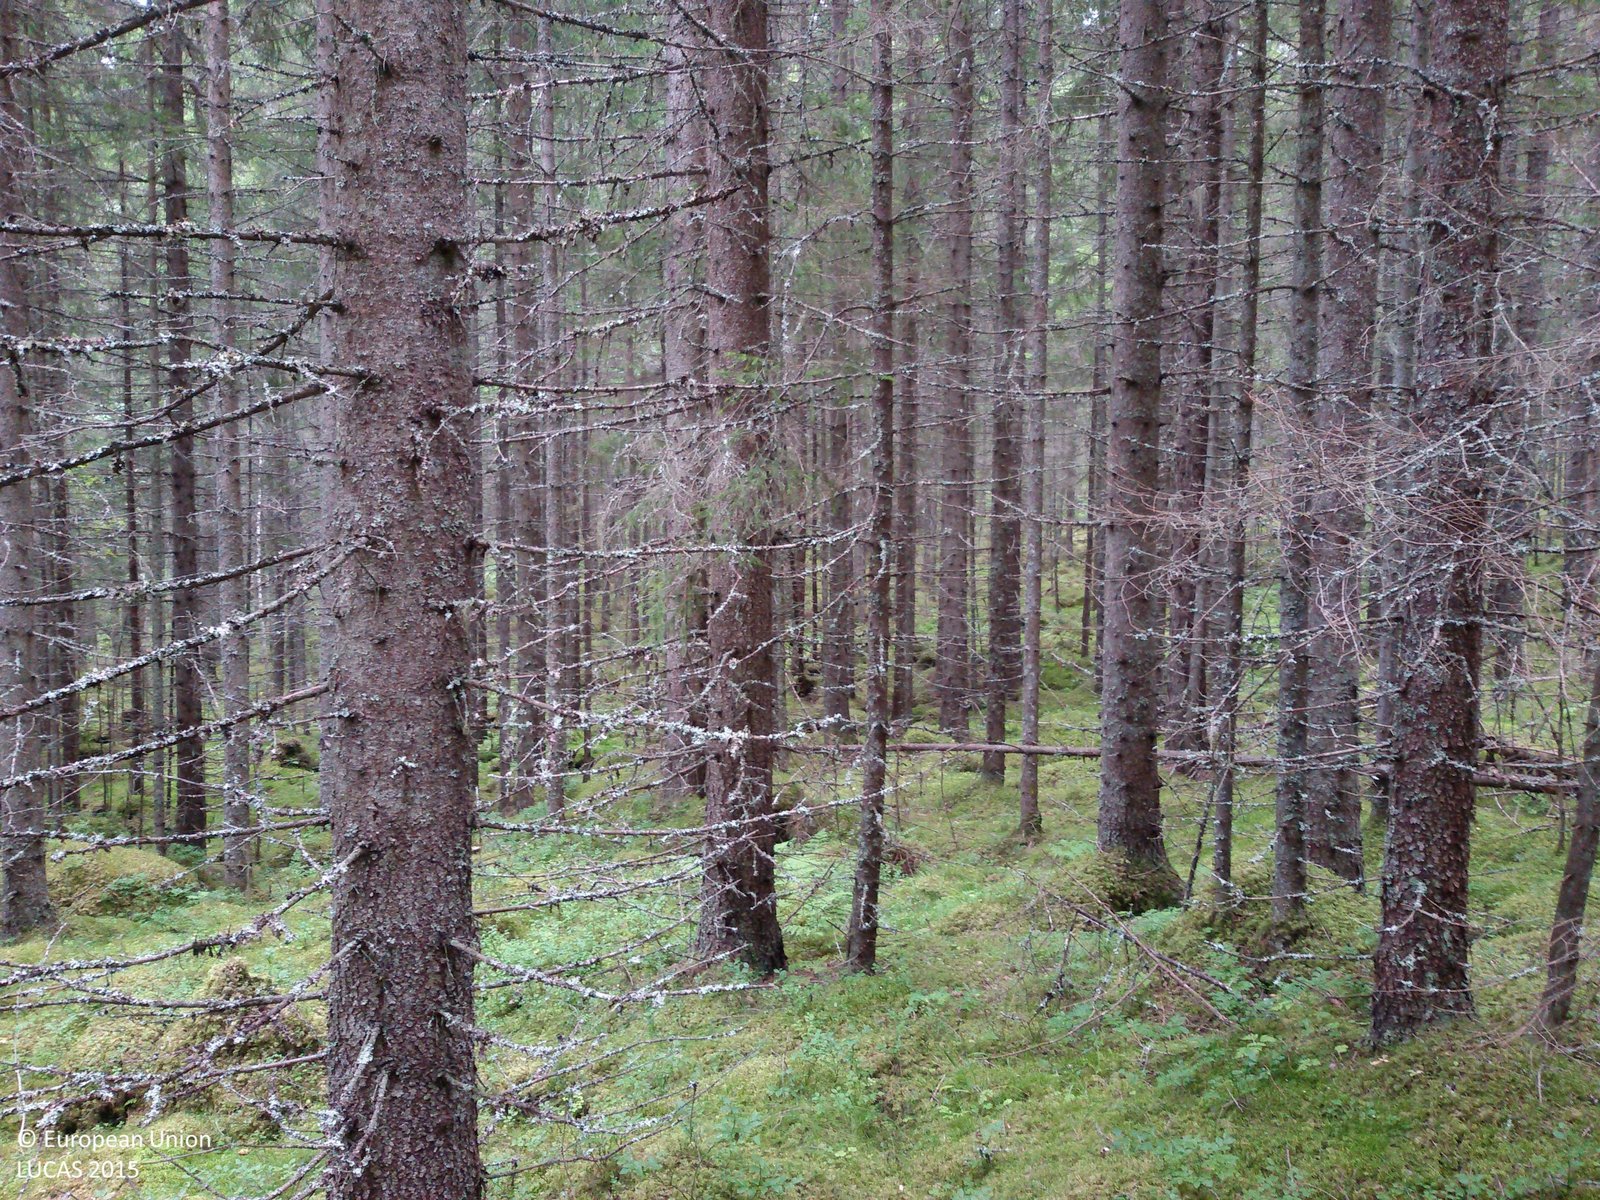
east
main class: Woodland
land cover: Spruce dominated coniferous woodland
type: boreal forest
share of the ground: > 75 %
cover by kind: coniferous forest trees 80 %, lichens and mosses 15 %, shrubs 5 %
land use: Forestry
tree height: > 5 m
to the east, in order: Spruce dominated coniferous woodland; Rivers and streams; Spruce dominated coniferous woodland
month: September
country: SE
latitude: 60.8251
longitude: 15.6690
